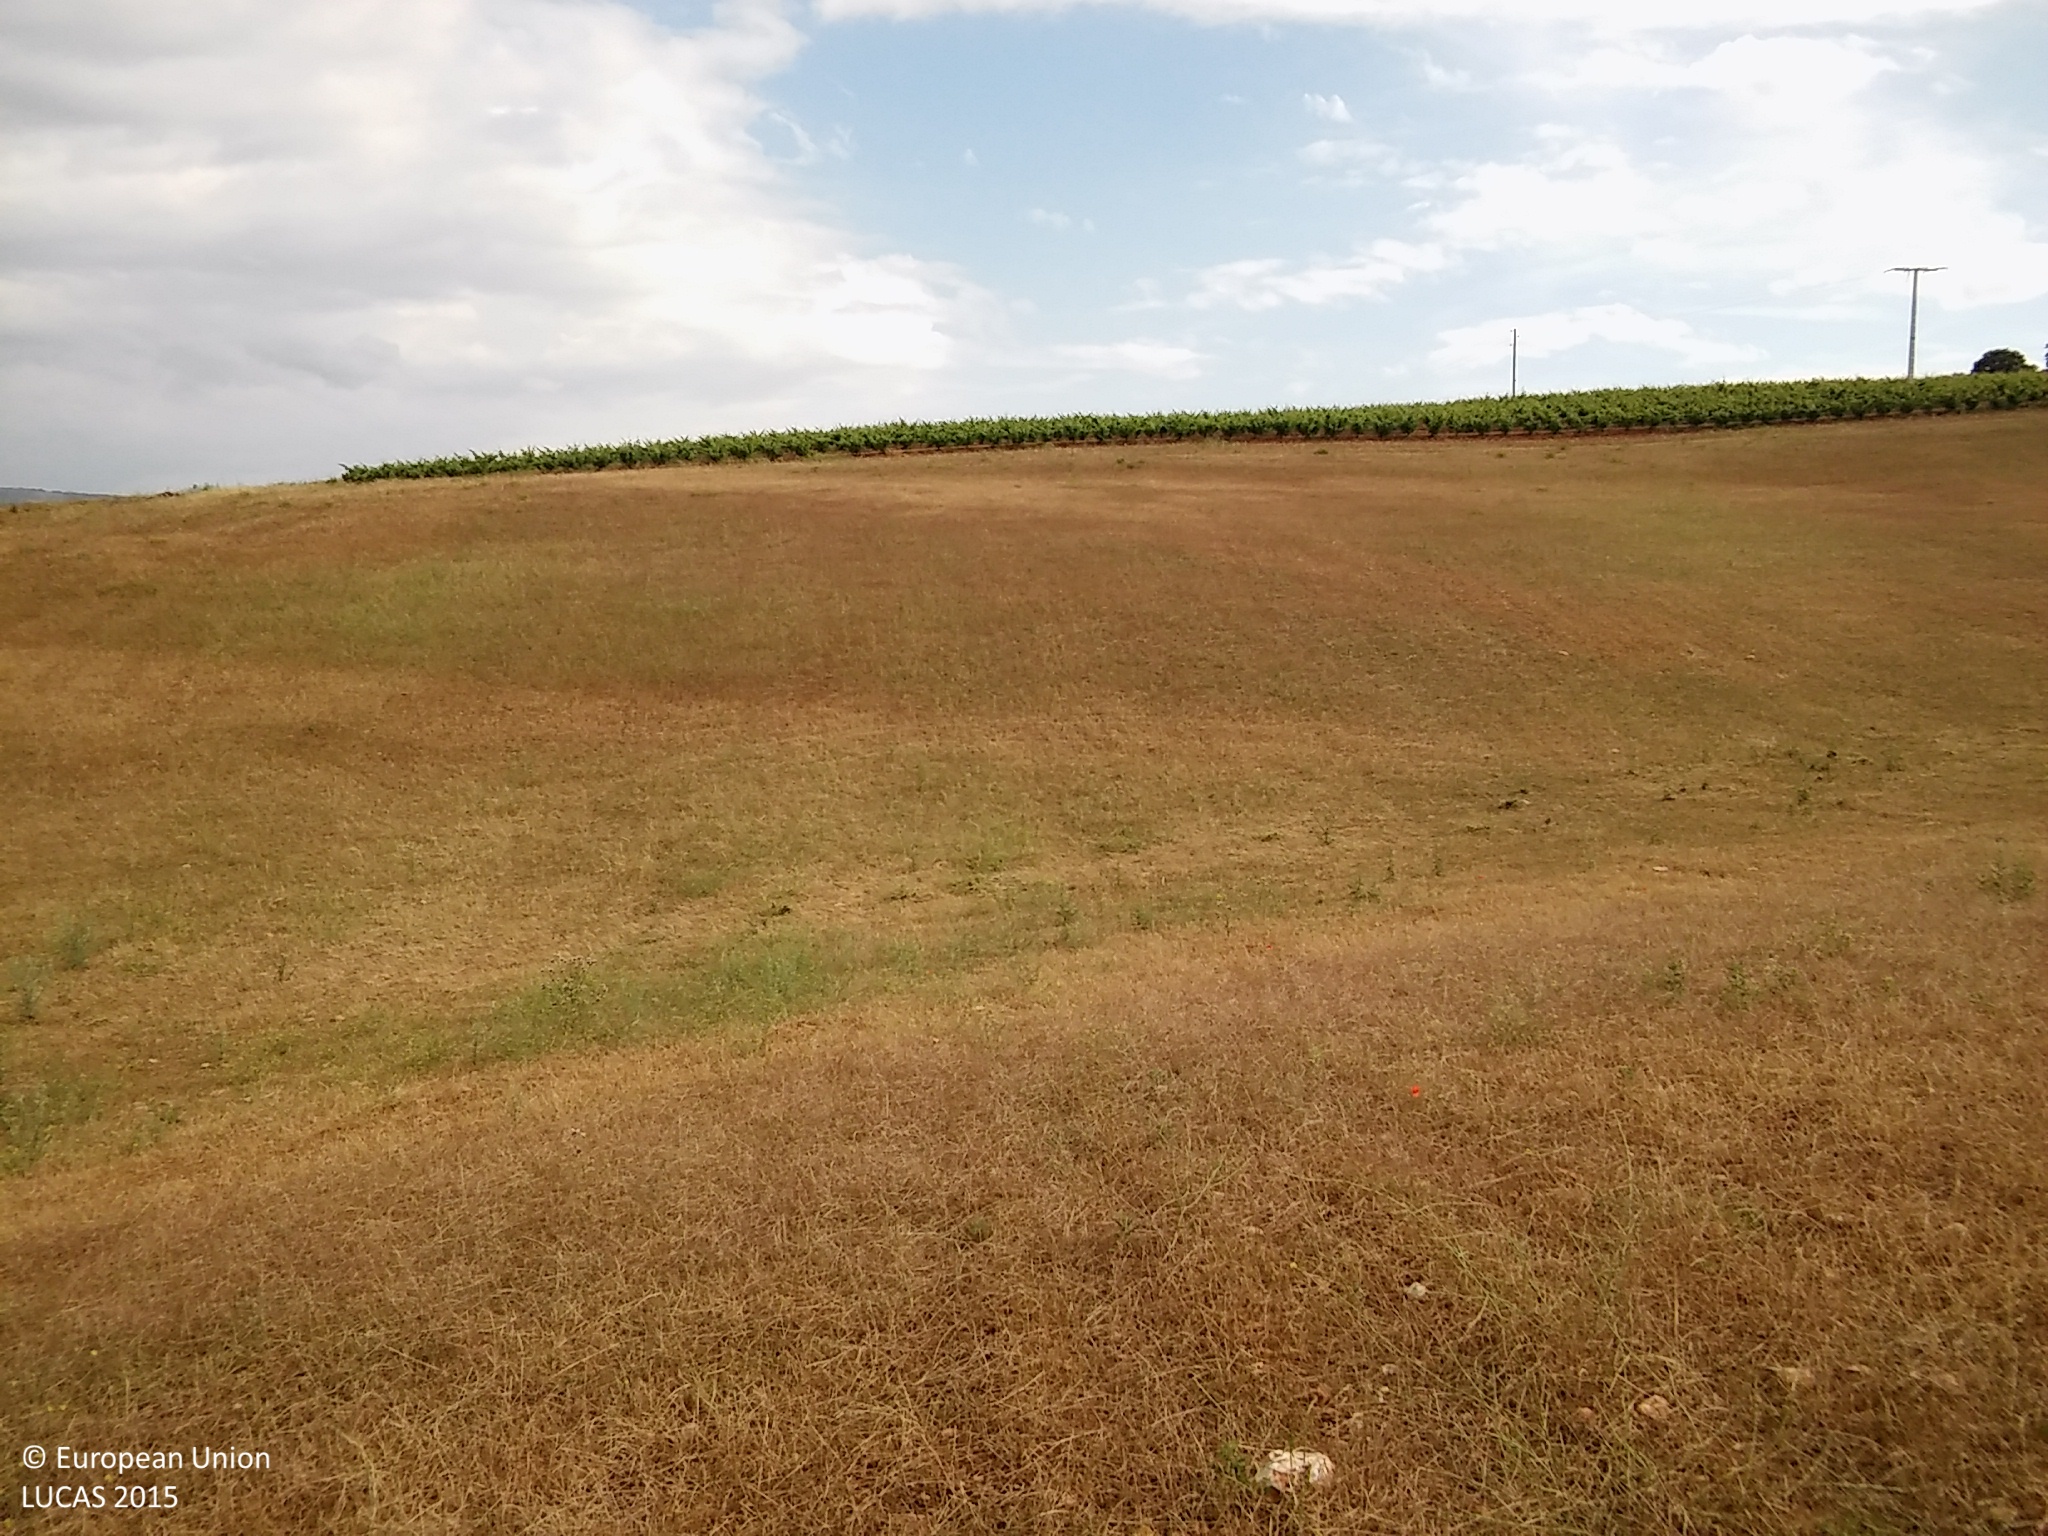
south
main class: Grassland
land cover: Spontaneously vegetated surfaces
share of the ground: > 75 %
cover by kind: herbaceous plants 60 %, unconsolidated bare surface 40 %
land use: Fallow land
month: June
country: ES
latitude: 41.5348
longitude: -3.7033
